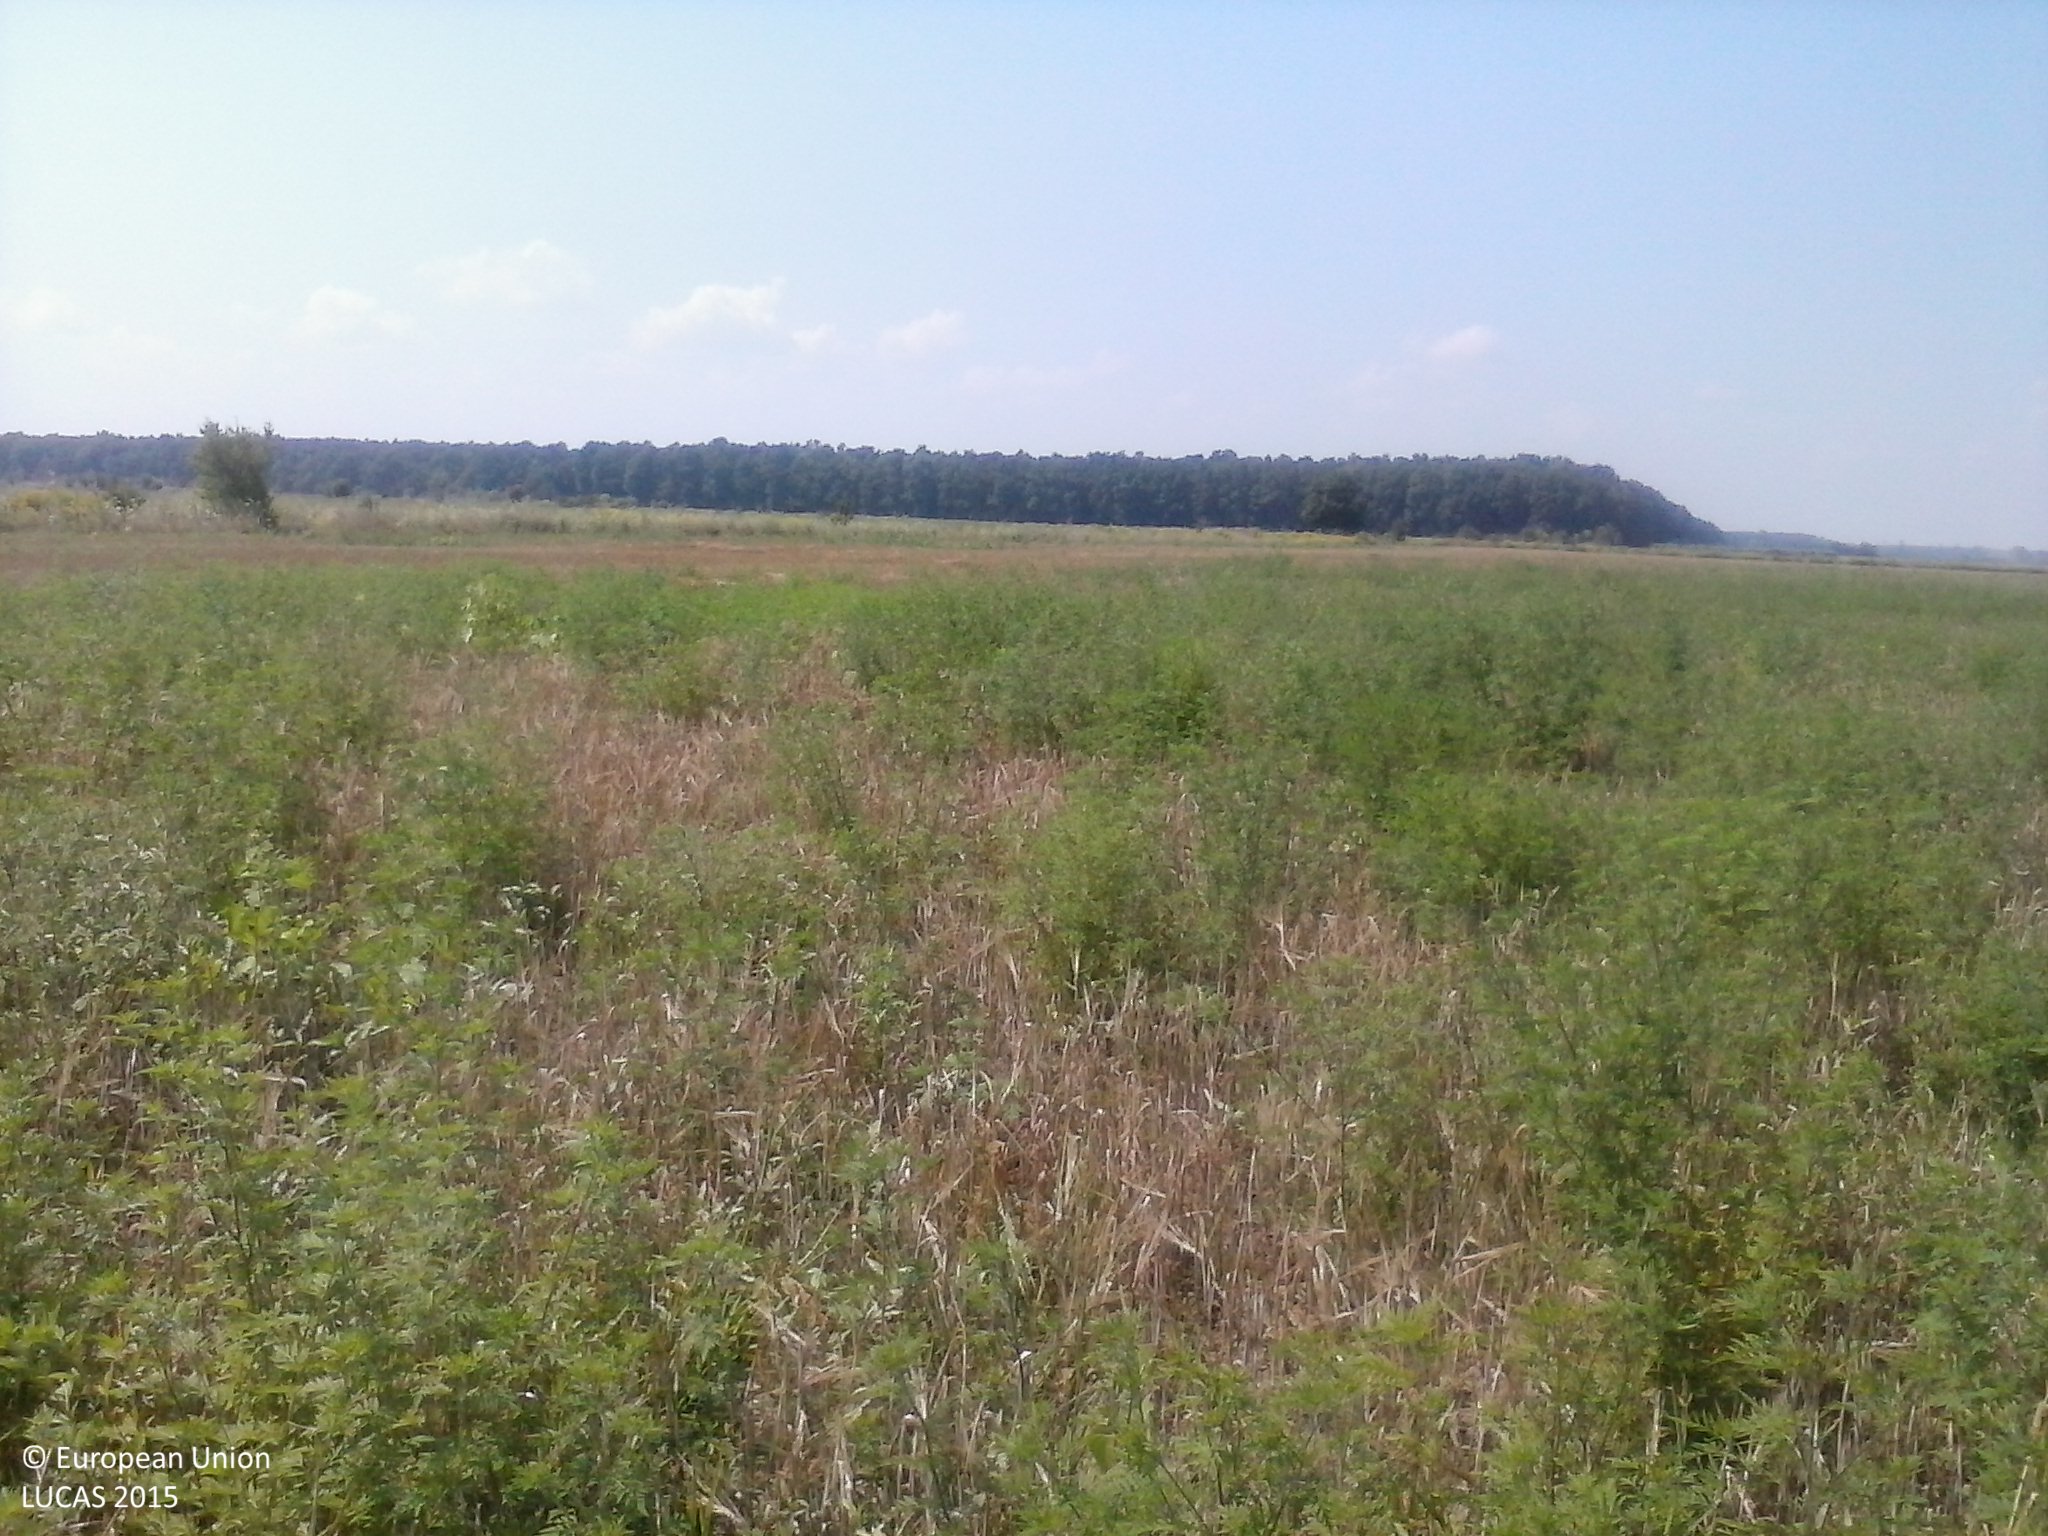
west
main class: Cropland
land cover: Triticale
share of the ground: 25 - 50 %
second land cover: Spontaneously vegetated surfaces
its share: 50 - 75 %
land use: Agriculture (excluding fallow land and kitchen gardens)
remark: Harvested field
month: August
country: HU
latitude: 45.9351
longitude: 17.8592
